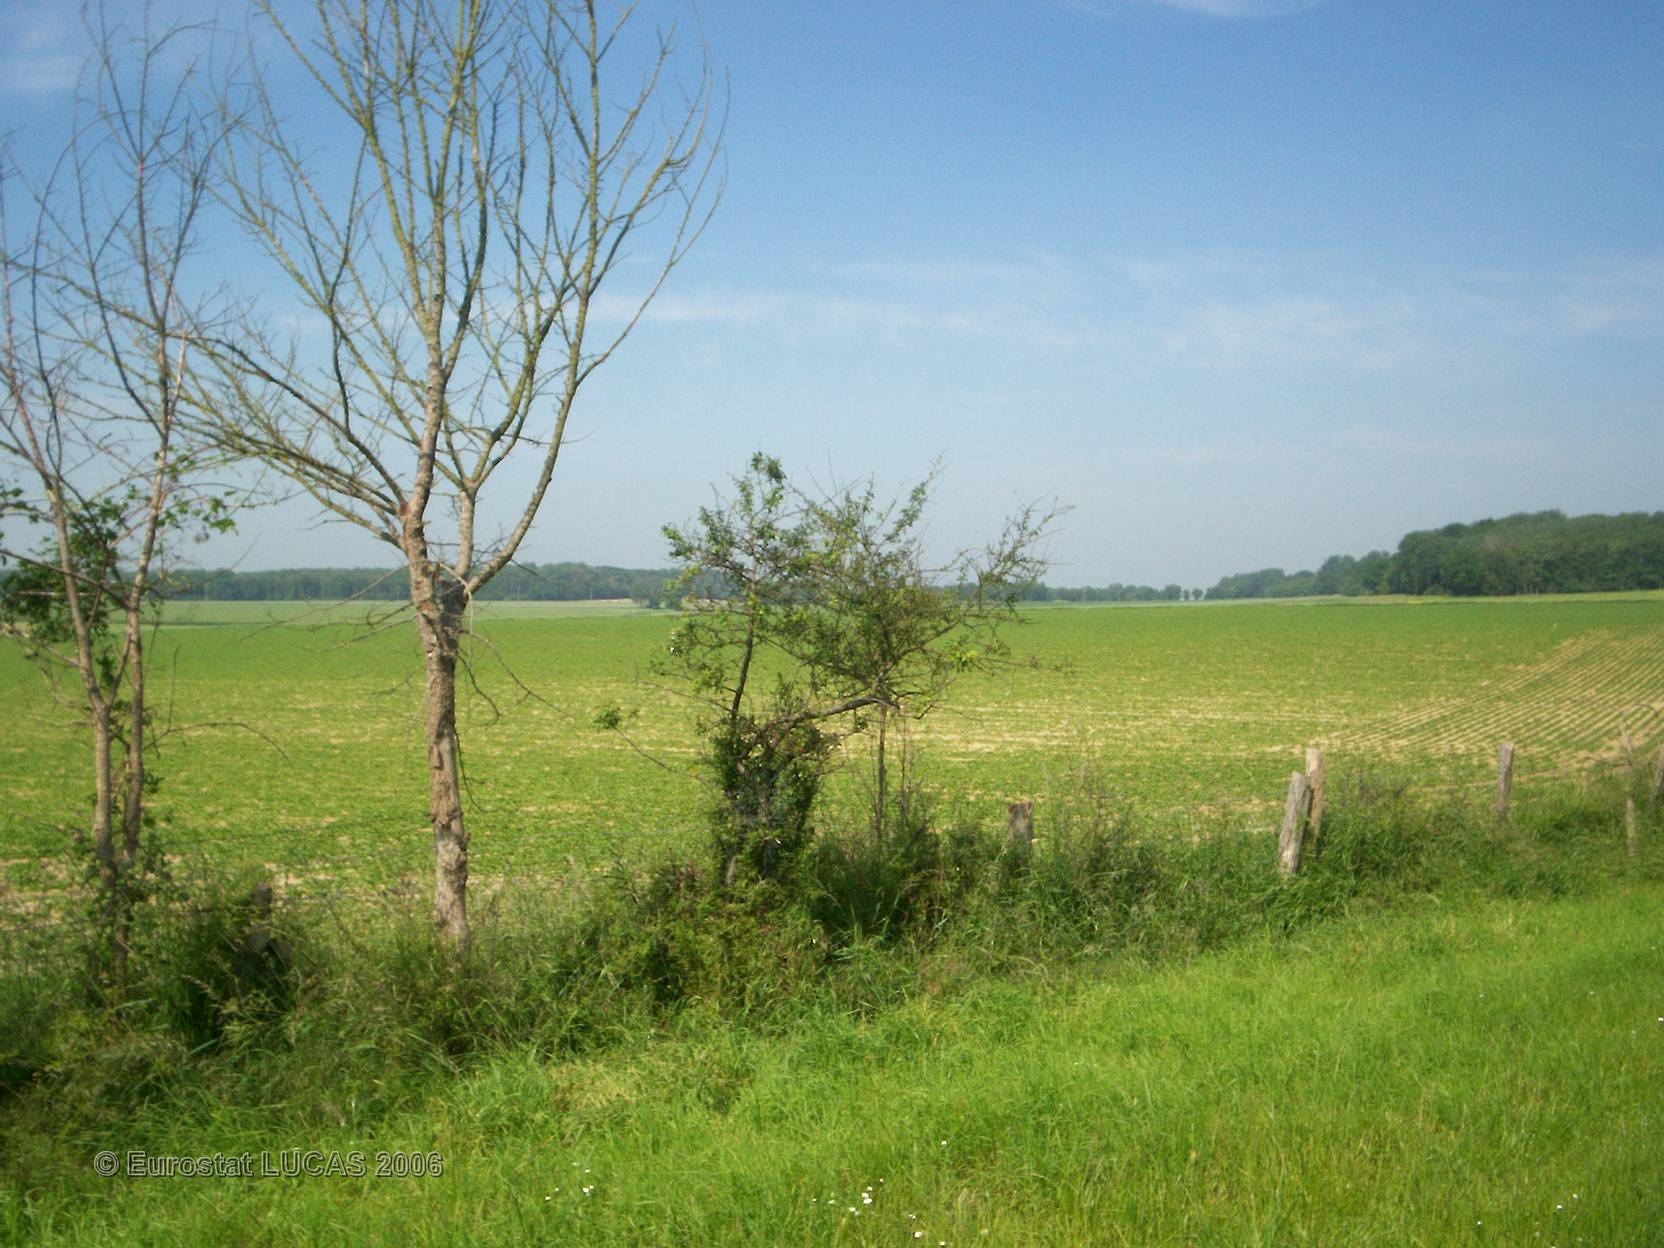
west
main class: Grassland
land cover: Grassland without tree/shrub cover
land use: Agriculture (excluding fallow land and kitchen gardens)
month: June
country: FR
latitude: 49.5710
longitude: 2.7016
